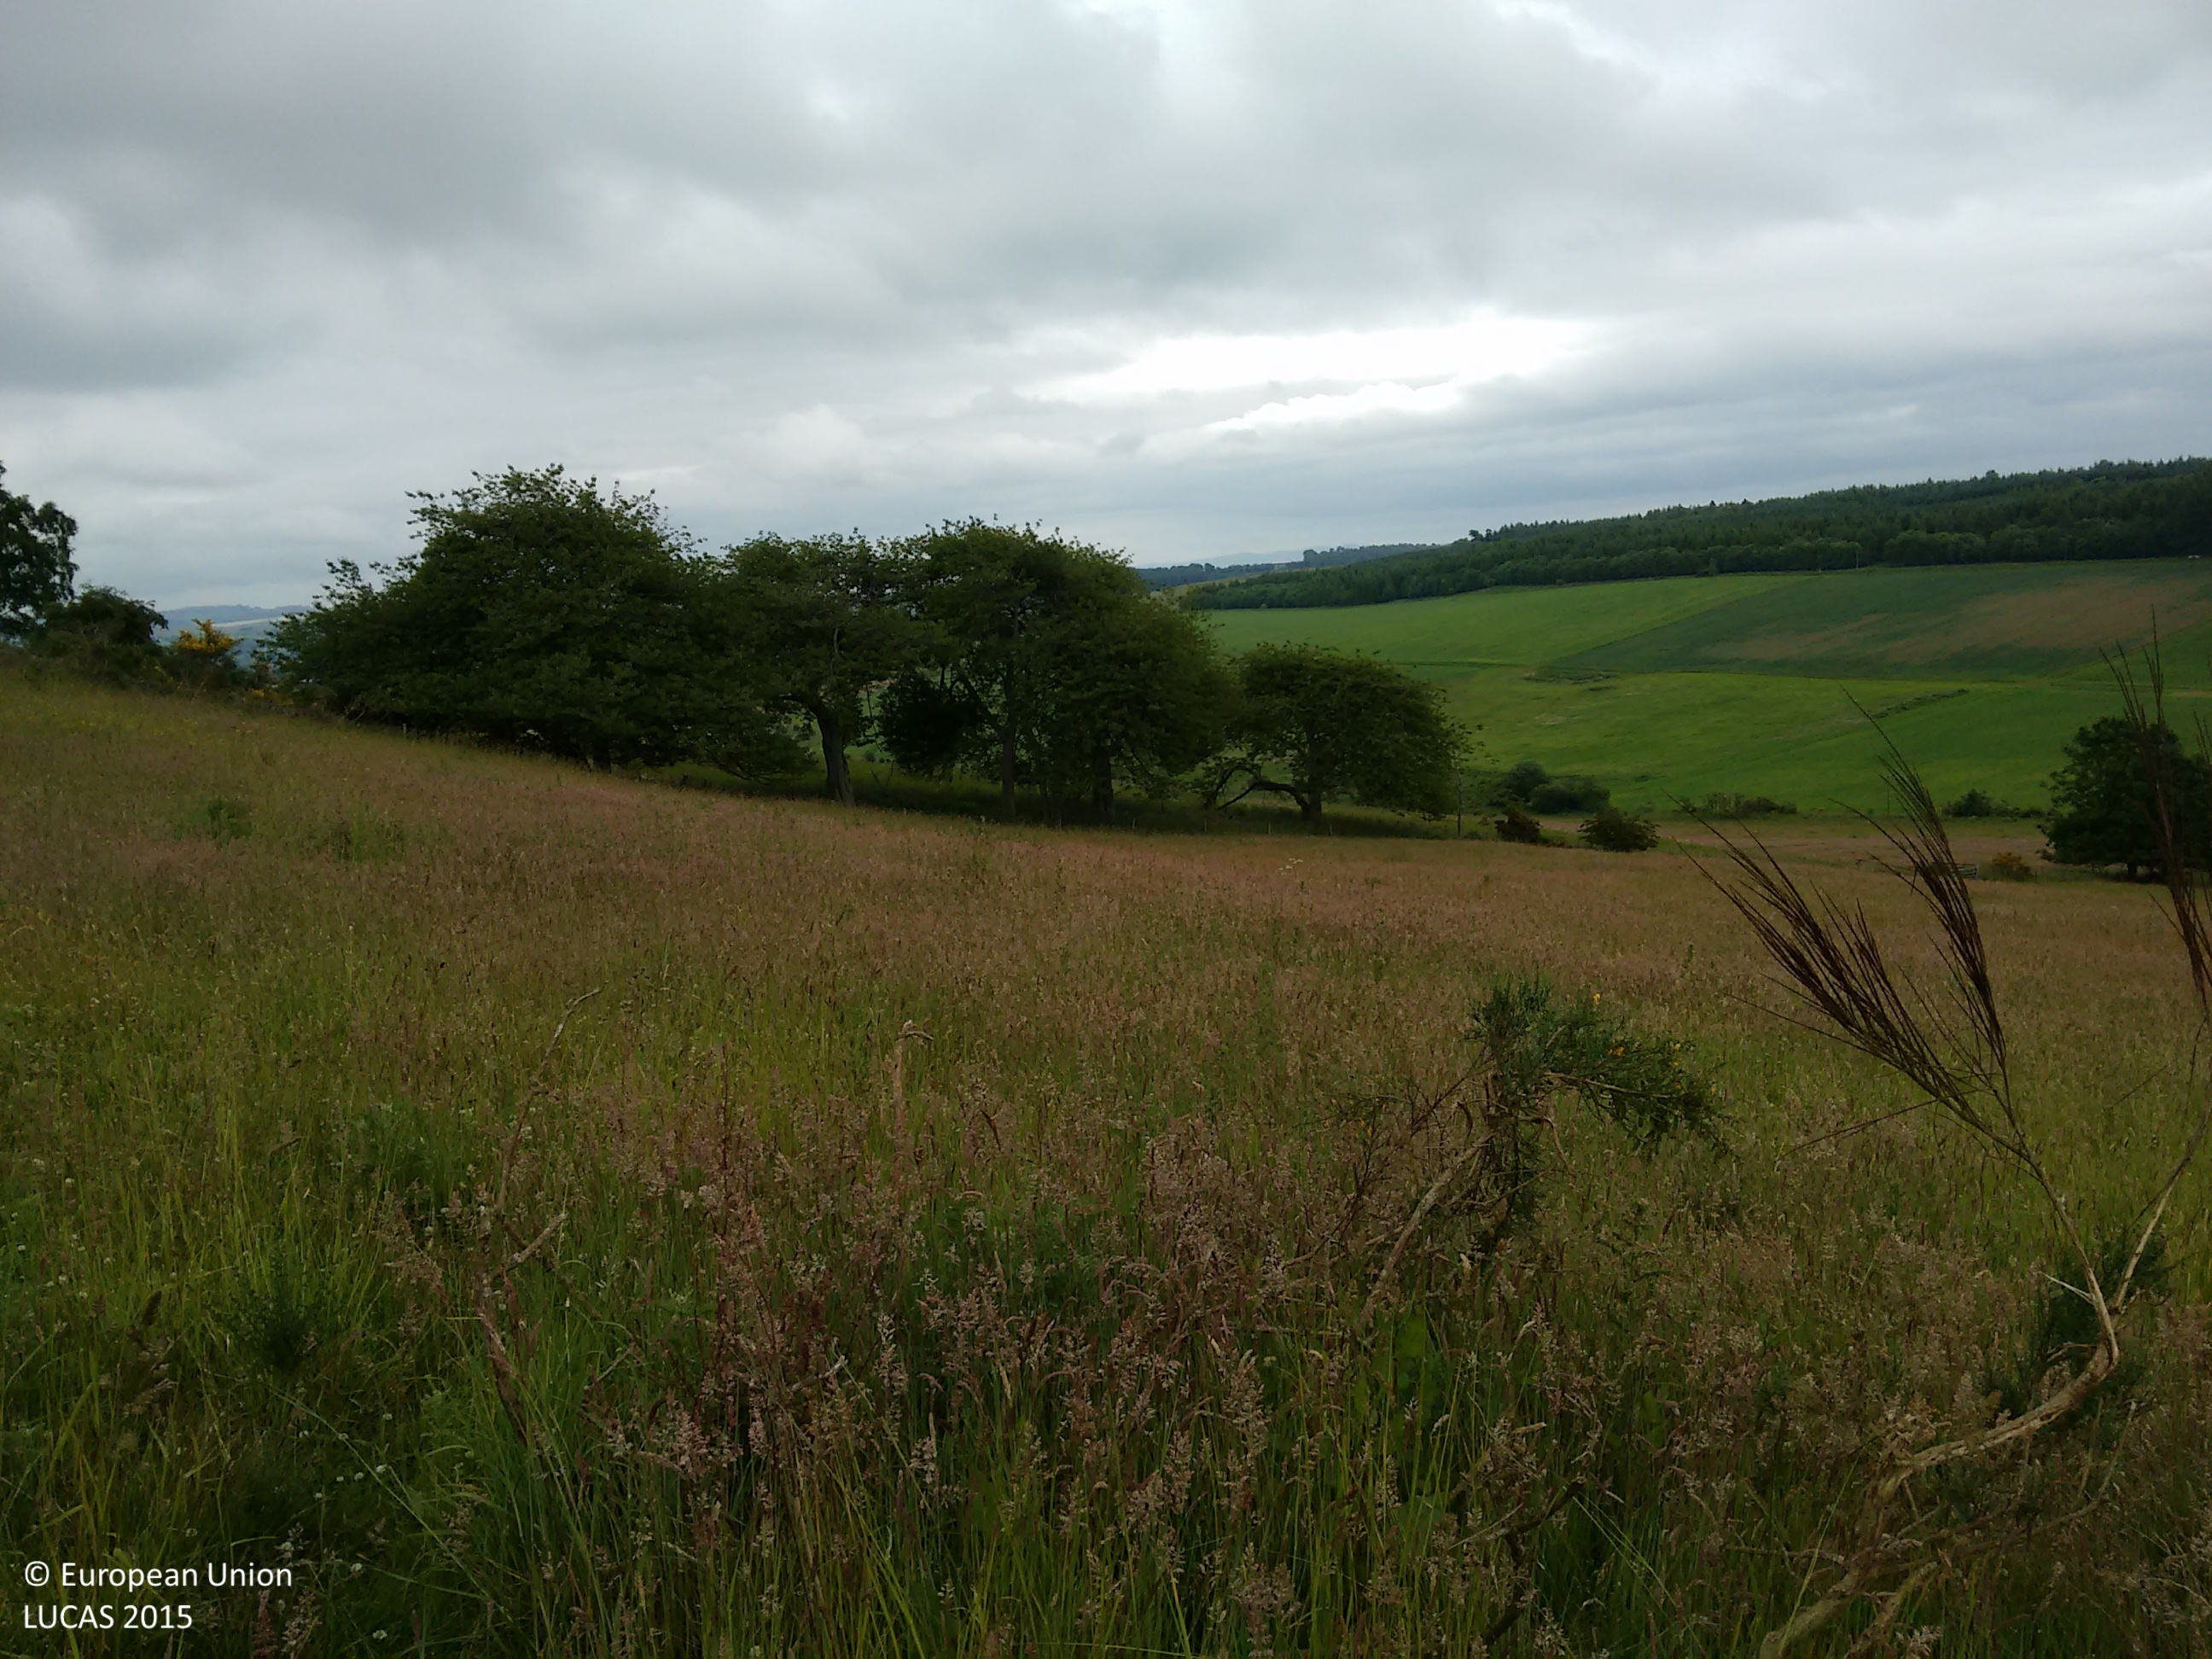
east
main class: Grassland
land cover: Spontaneously vegetated surfaces
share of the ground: > 75 %
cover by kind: herbaceous plants 100 %
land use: Semi-natural and natural areas not in use
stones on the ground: 10 - 25 %
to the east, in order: Spontaneously vegetated surfaces; Fences; Lines of trees; Dry stone walls; Fences; Spontaneously vegetated surfaces; Fences; Grassland without tree/shrub cover; Tracks; Grassland with sparse tree/shrub cover; Grassland without tree/shrub cover
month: June
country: GB
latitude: 56.5690
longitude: -3.4684
